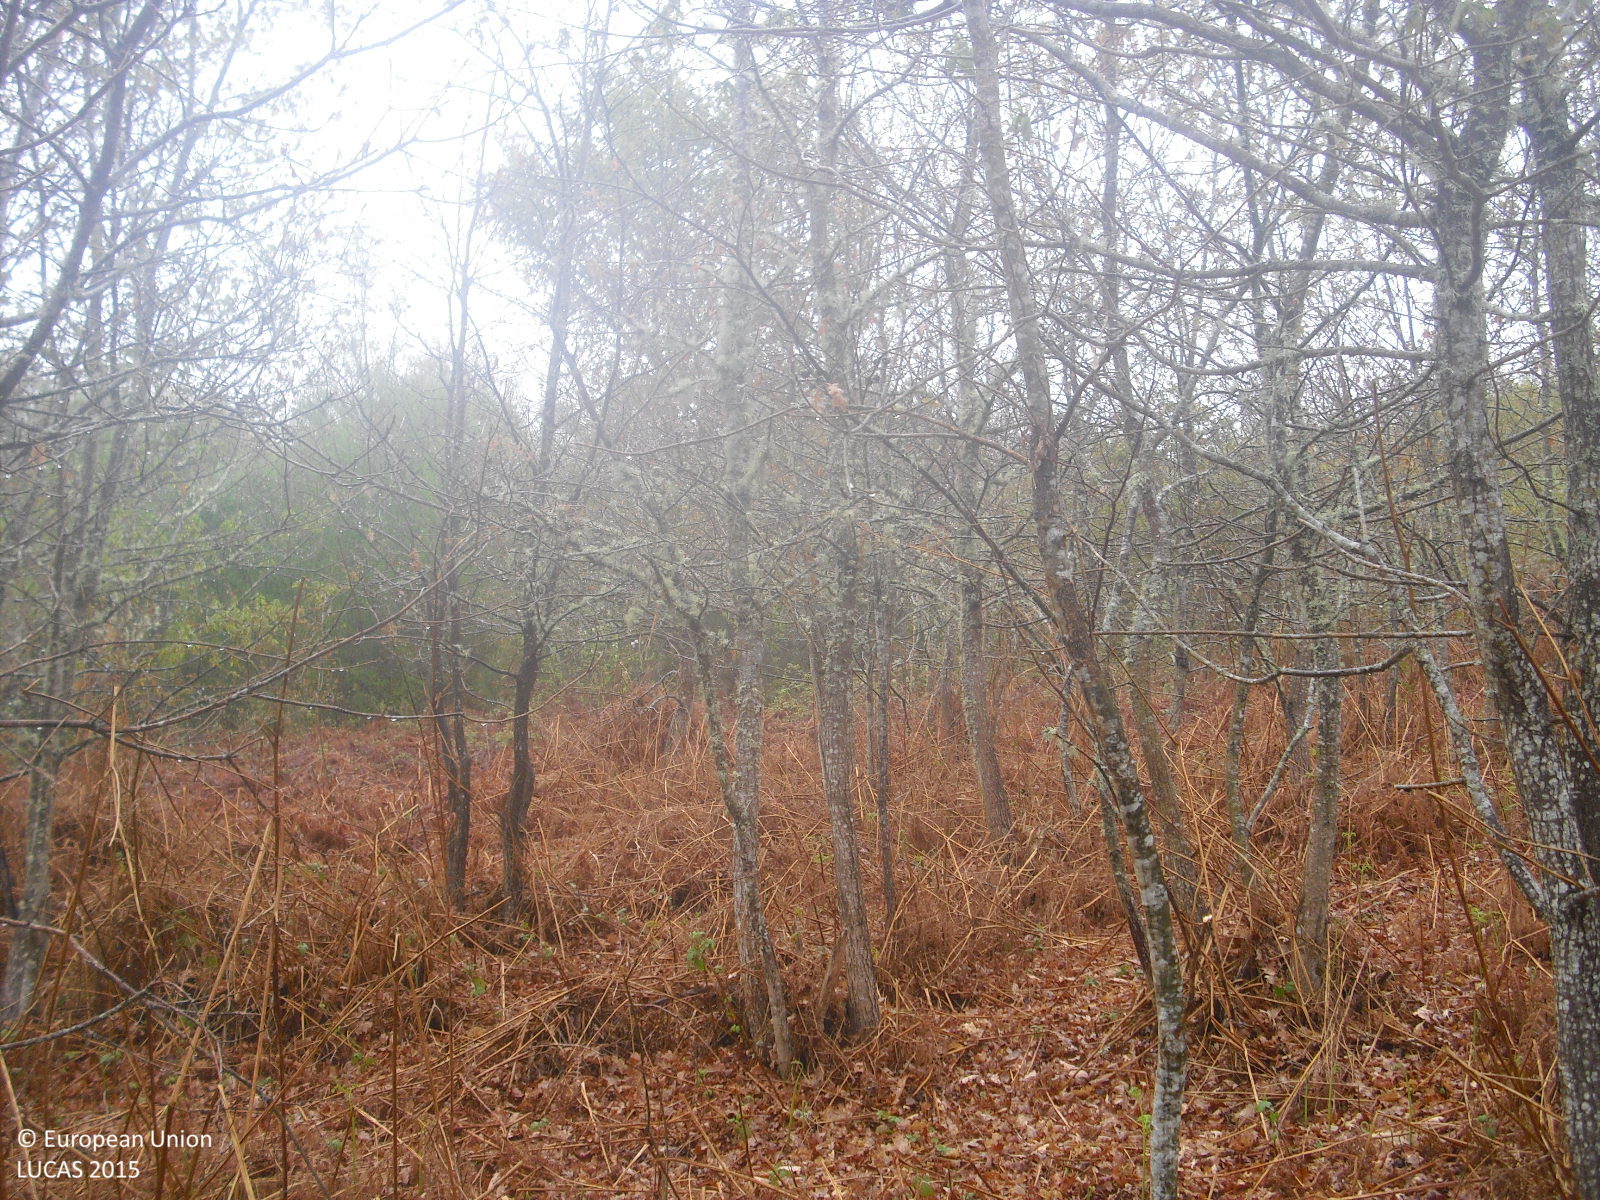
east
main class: Woodland
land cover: Broadleaved woodland
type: thermophilous deciduous forest
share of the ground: 50 - 75 %
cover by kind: shrubs 50 %, broadleaved forest trees 40 %, herbaceous plants 10 %
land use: Forestry
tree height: < 5 m
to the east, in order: Broadleaved woodland; Ditches and canals; Broadleaved woodland; Shrubland with sparse tree cover; Broadleaved woodland; Shrubland without tree cover
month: April
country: ES
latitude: 42.1118
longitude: -7.9140
